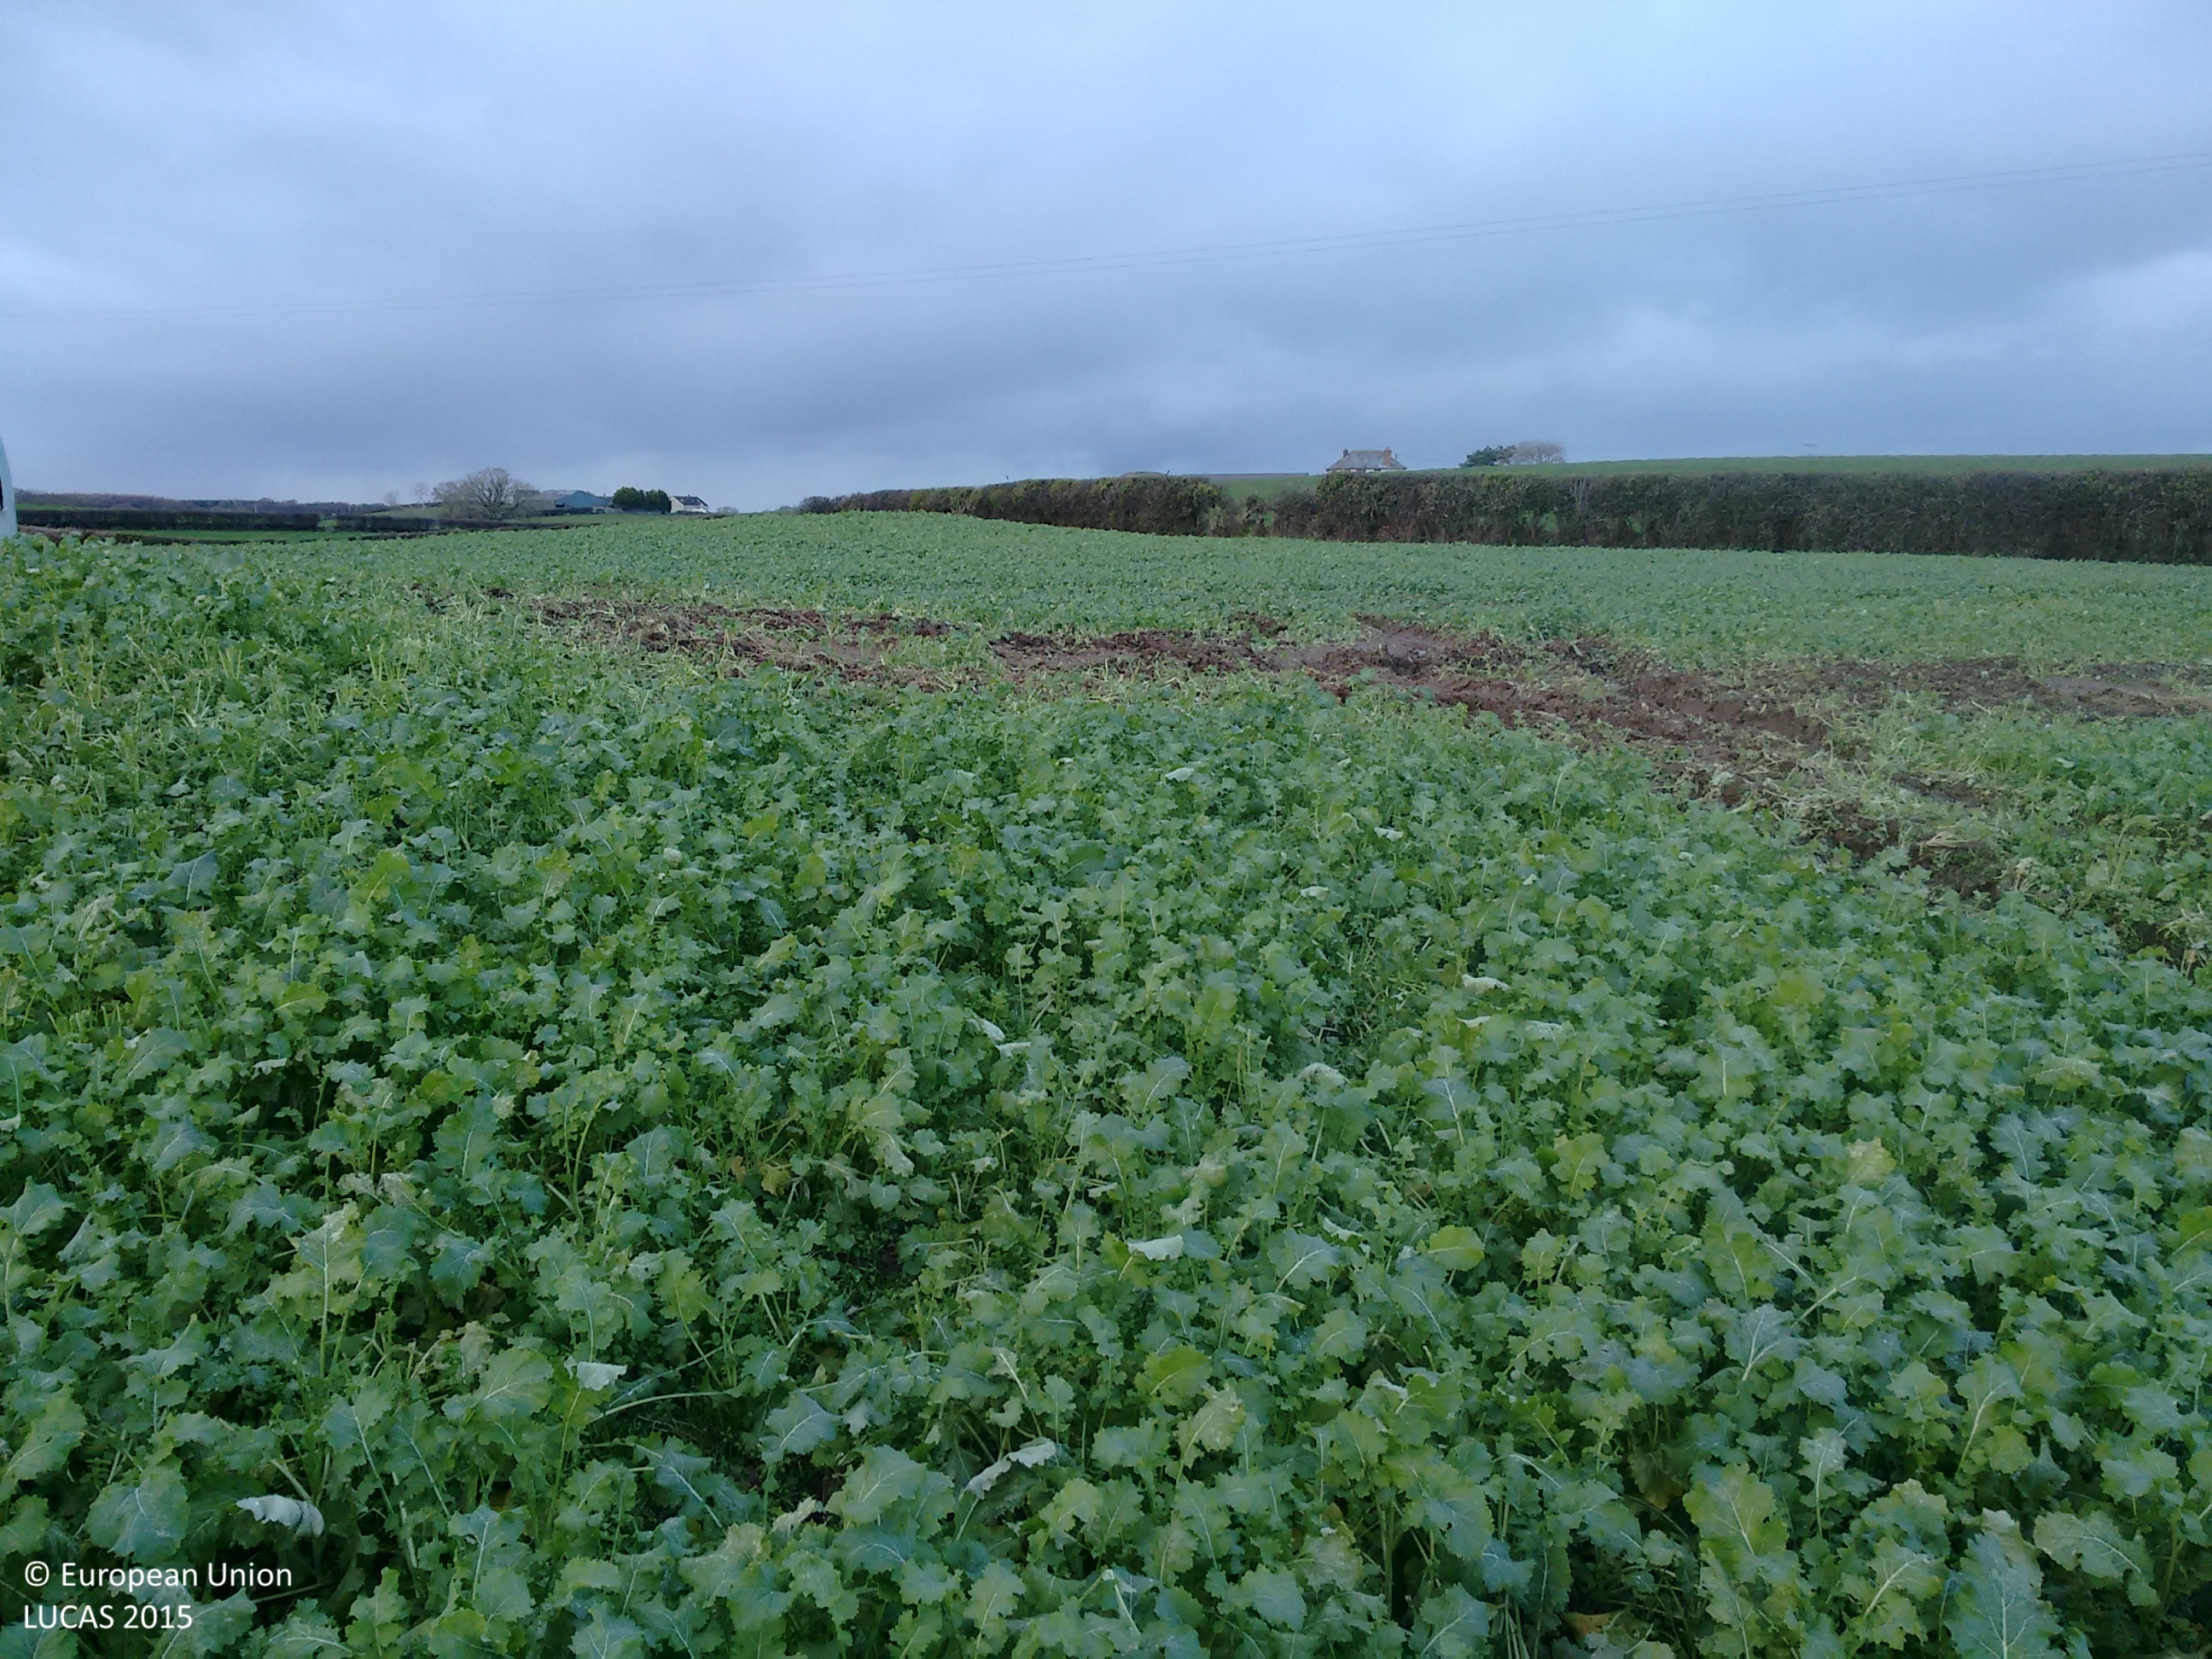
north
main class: Cropland
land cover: Other fresh vegetables
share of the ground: > 75 %
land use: Agriculture (excluding fallow land and kitchen gardens)
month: November
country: GB
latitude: 54.5493
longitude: -5.5737
